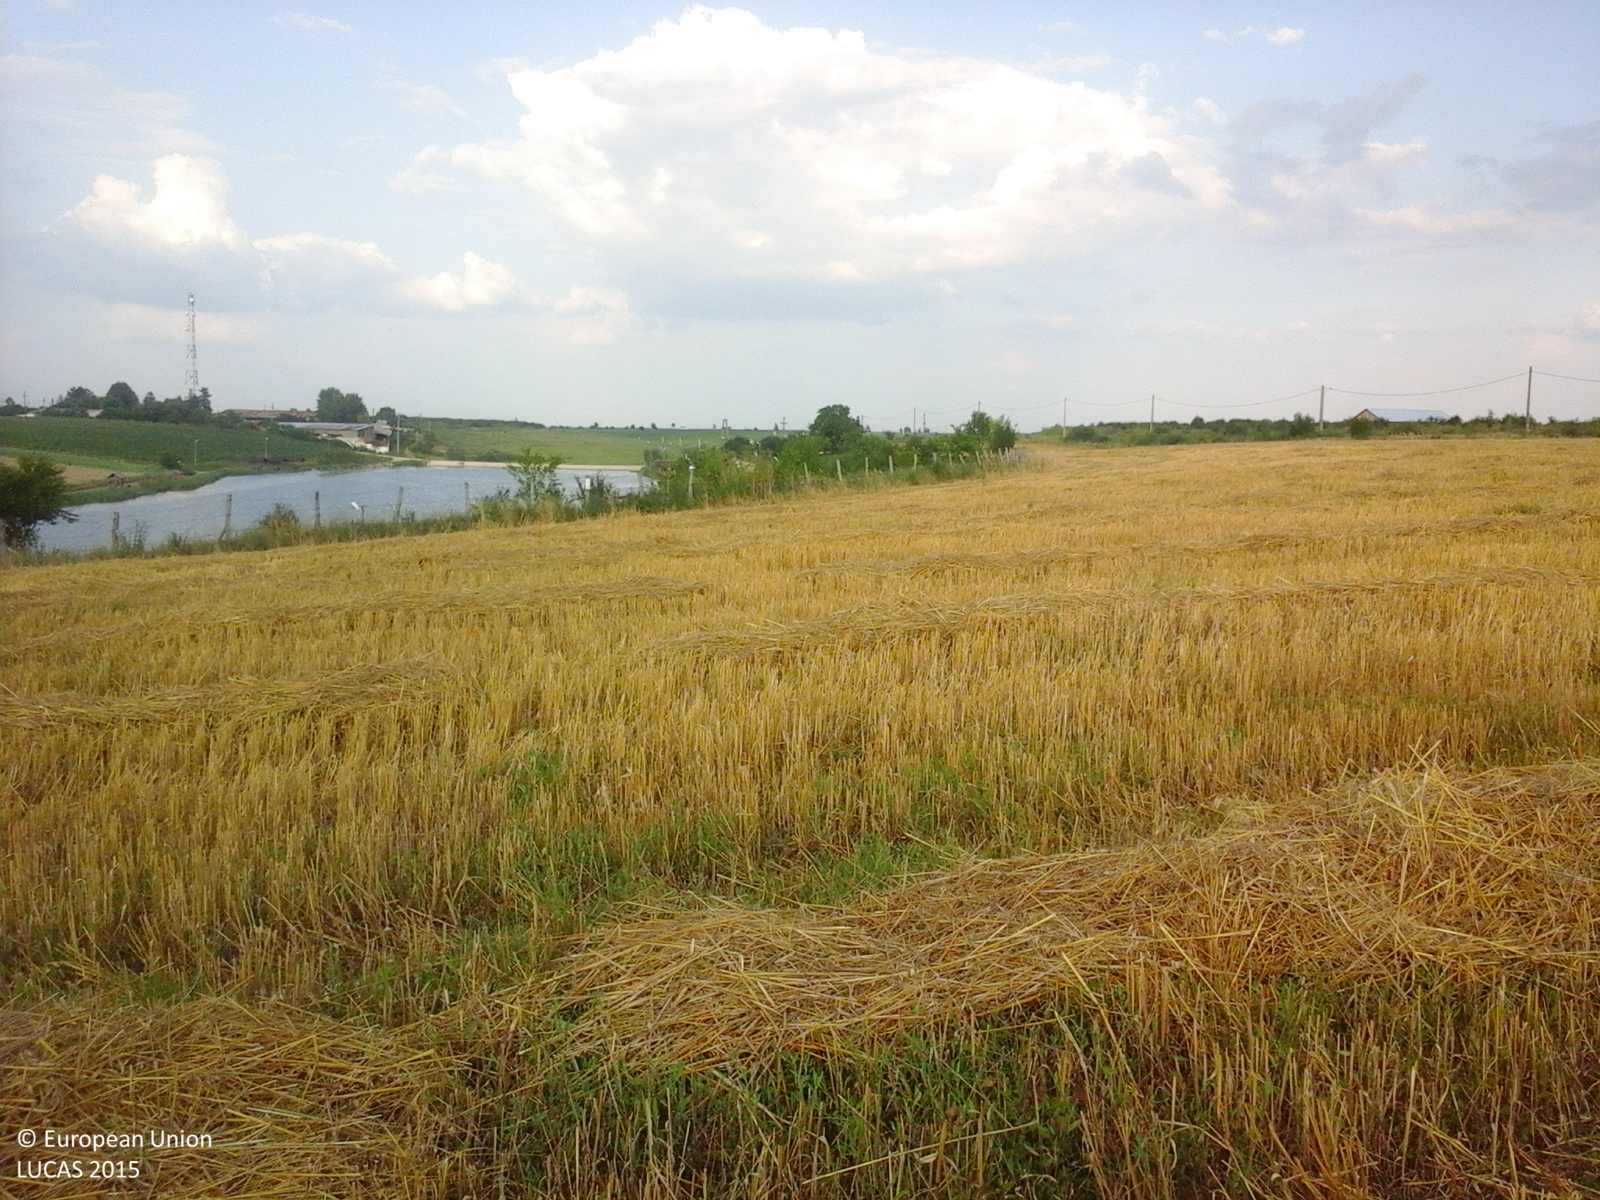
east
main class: Cropland
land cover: Barley
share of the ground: 10 - 25 %
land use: Agriculture (excluding fallow land and kitchen gardens)
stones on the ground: < 10 %
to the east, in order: Barley; Fences; Other fruit trees and berries; Grass margins; Tracks; Grass margins; Inland fresh running water
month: July
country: RO
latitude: 44.2483
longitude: 25.8130
